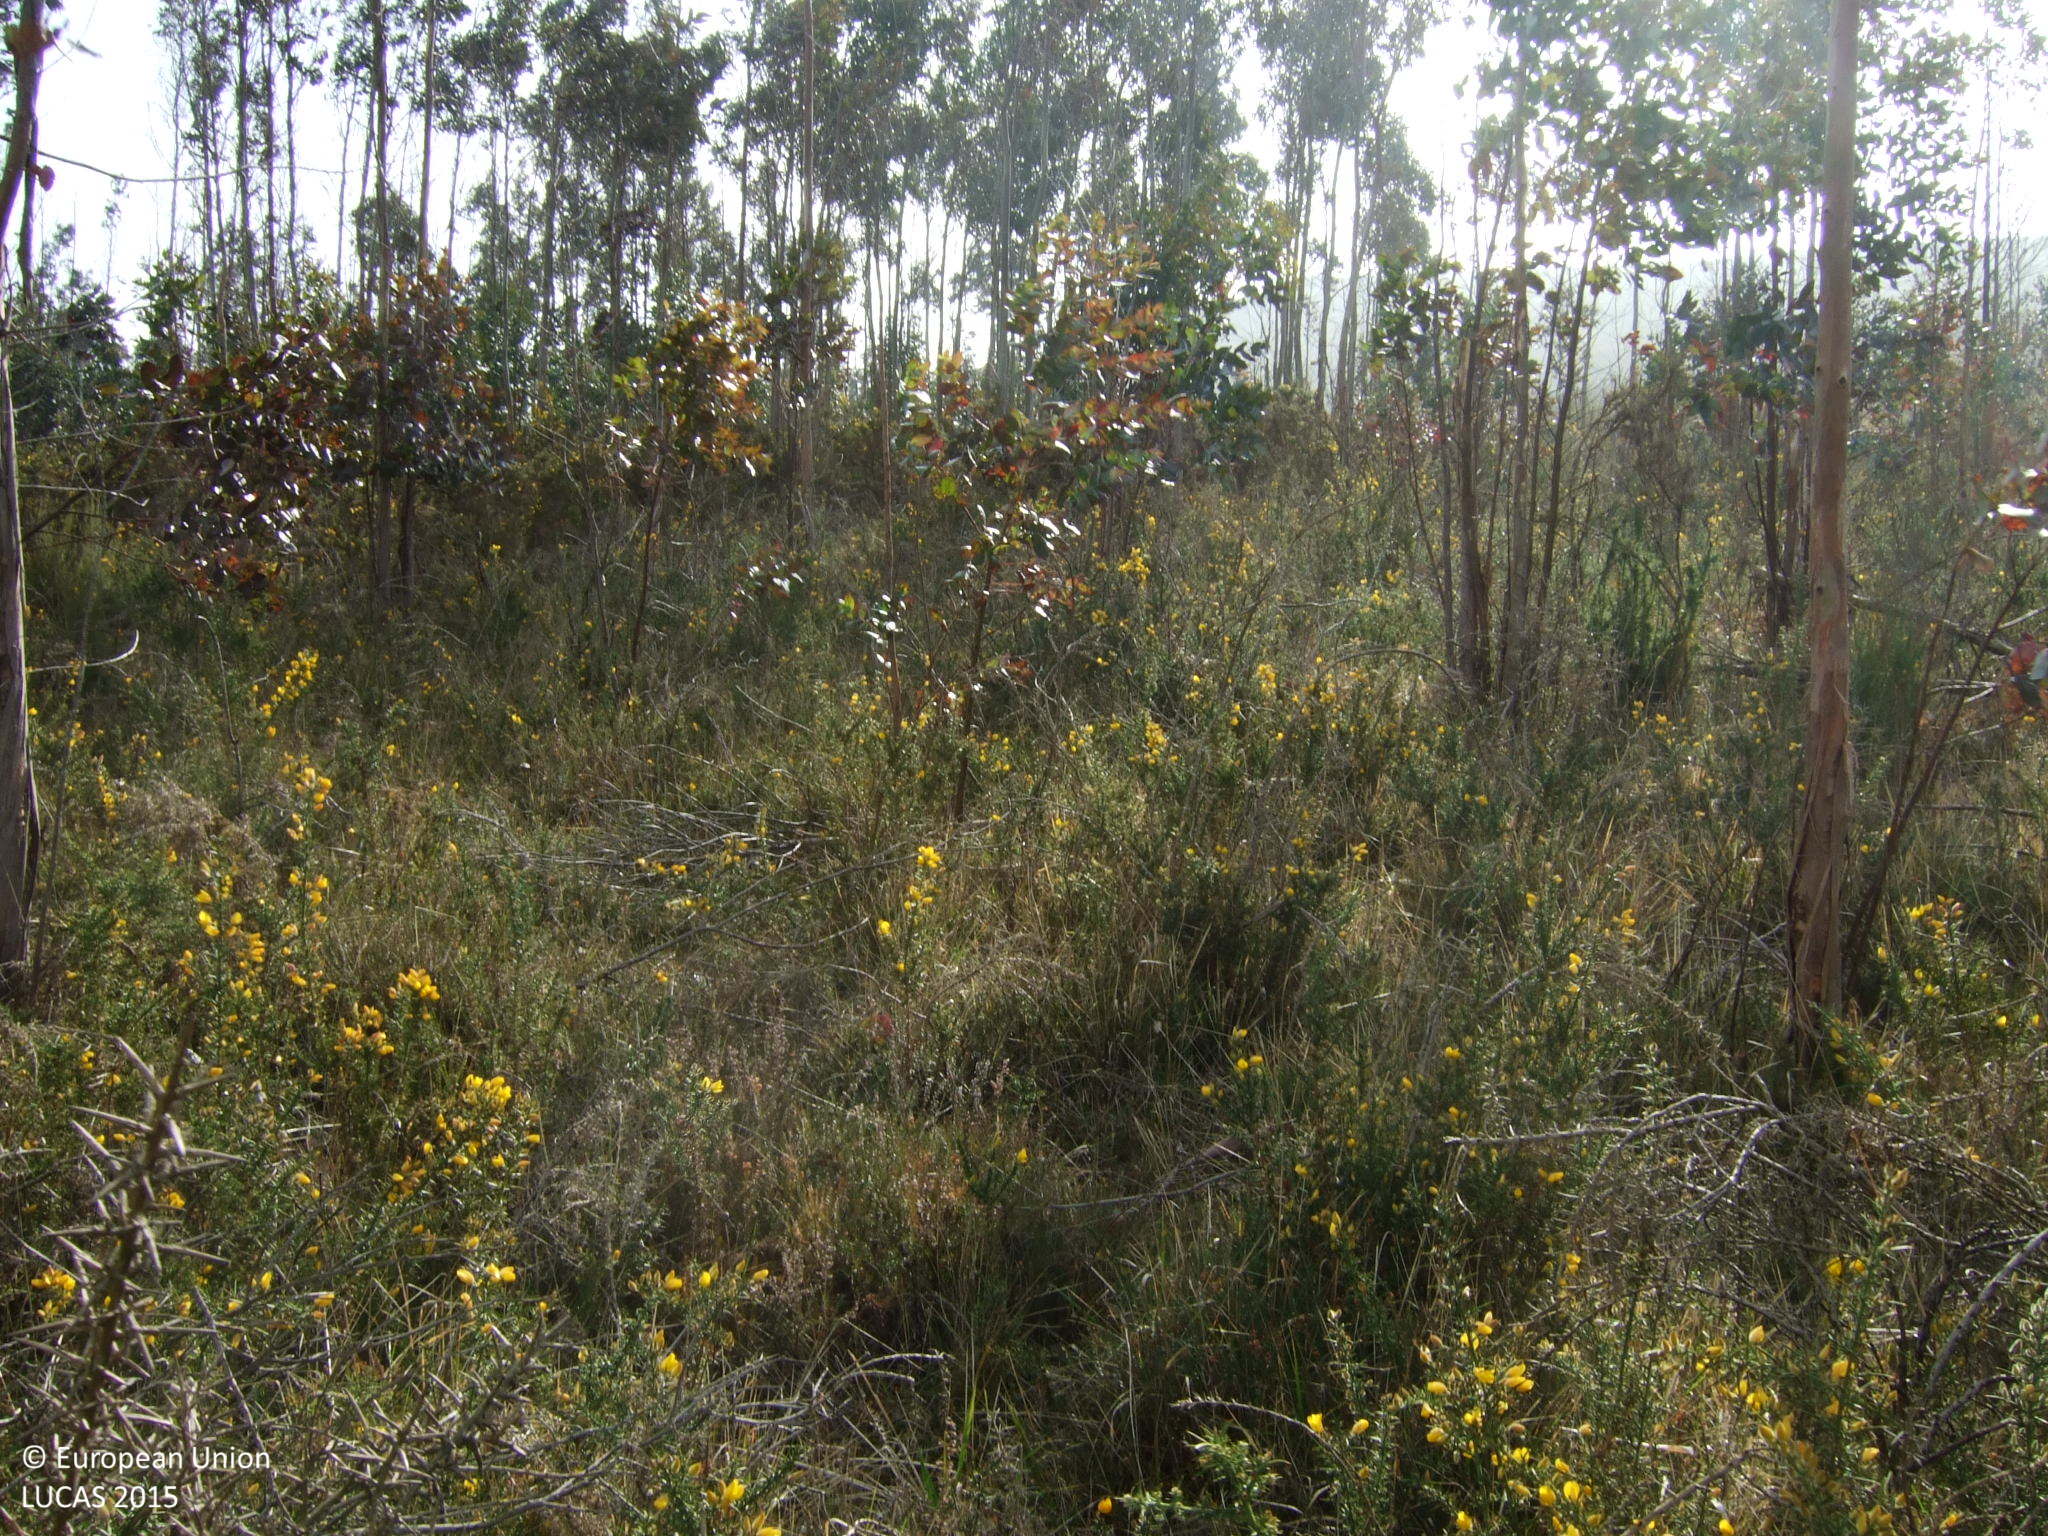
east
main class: Woodland
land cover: Broadleaved woodland
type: exotic forest
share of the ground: 10 - 25 %
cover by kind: shrubs 85 %, broadleaved forest trees 15 %
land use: Forestry
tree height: < 5 m
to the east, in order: Broadleaved woodland; Fences; Broadleaved woodland; Shrubland with sparse tree cover; Broadleaved woodland
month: March
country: ES
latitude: 42.9370
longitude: -7.9417
